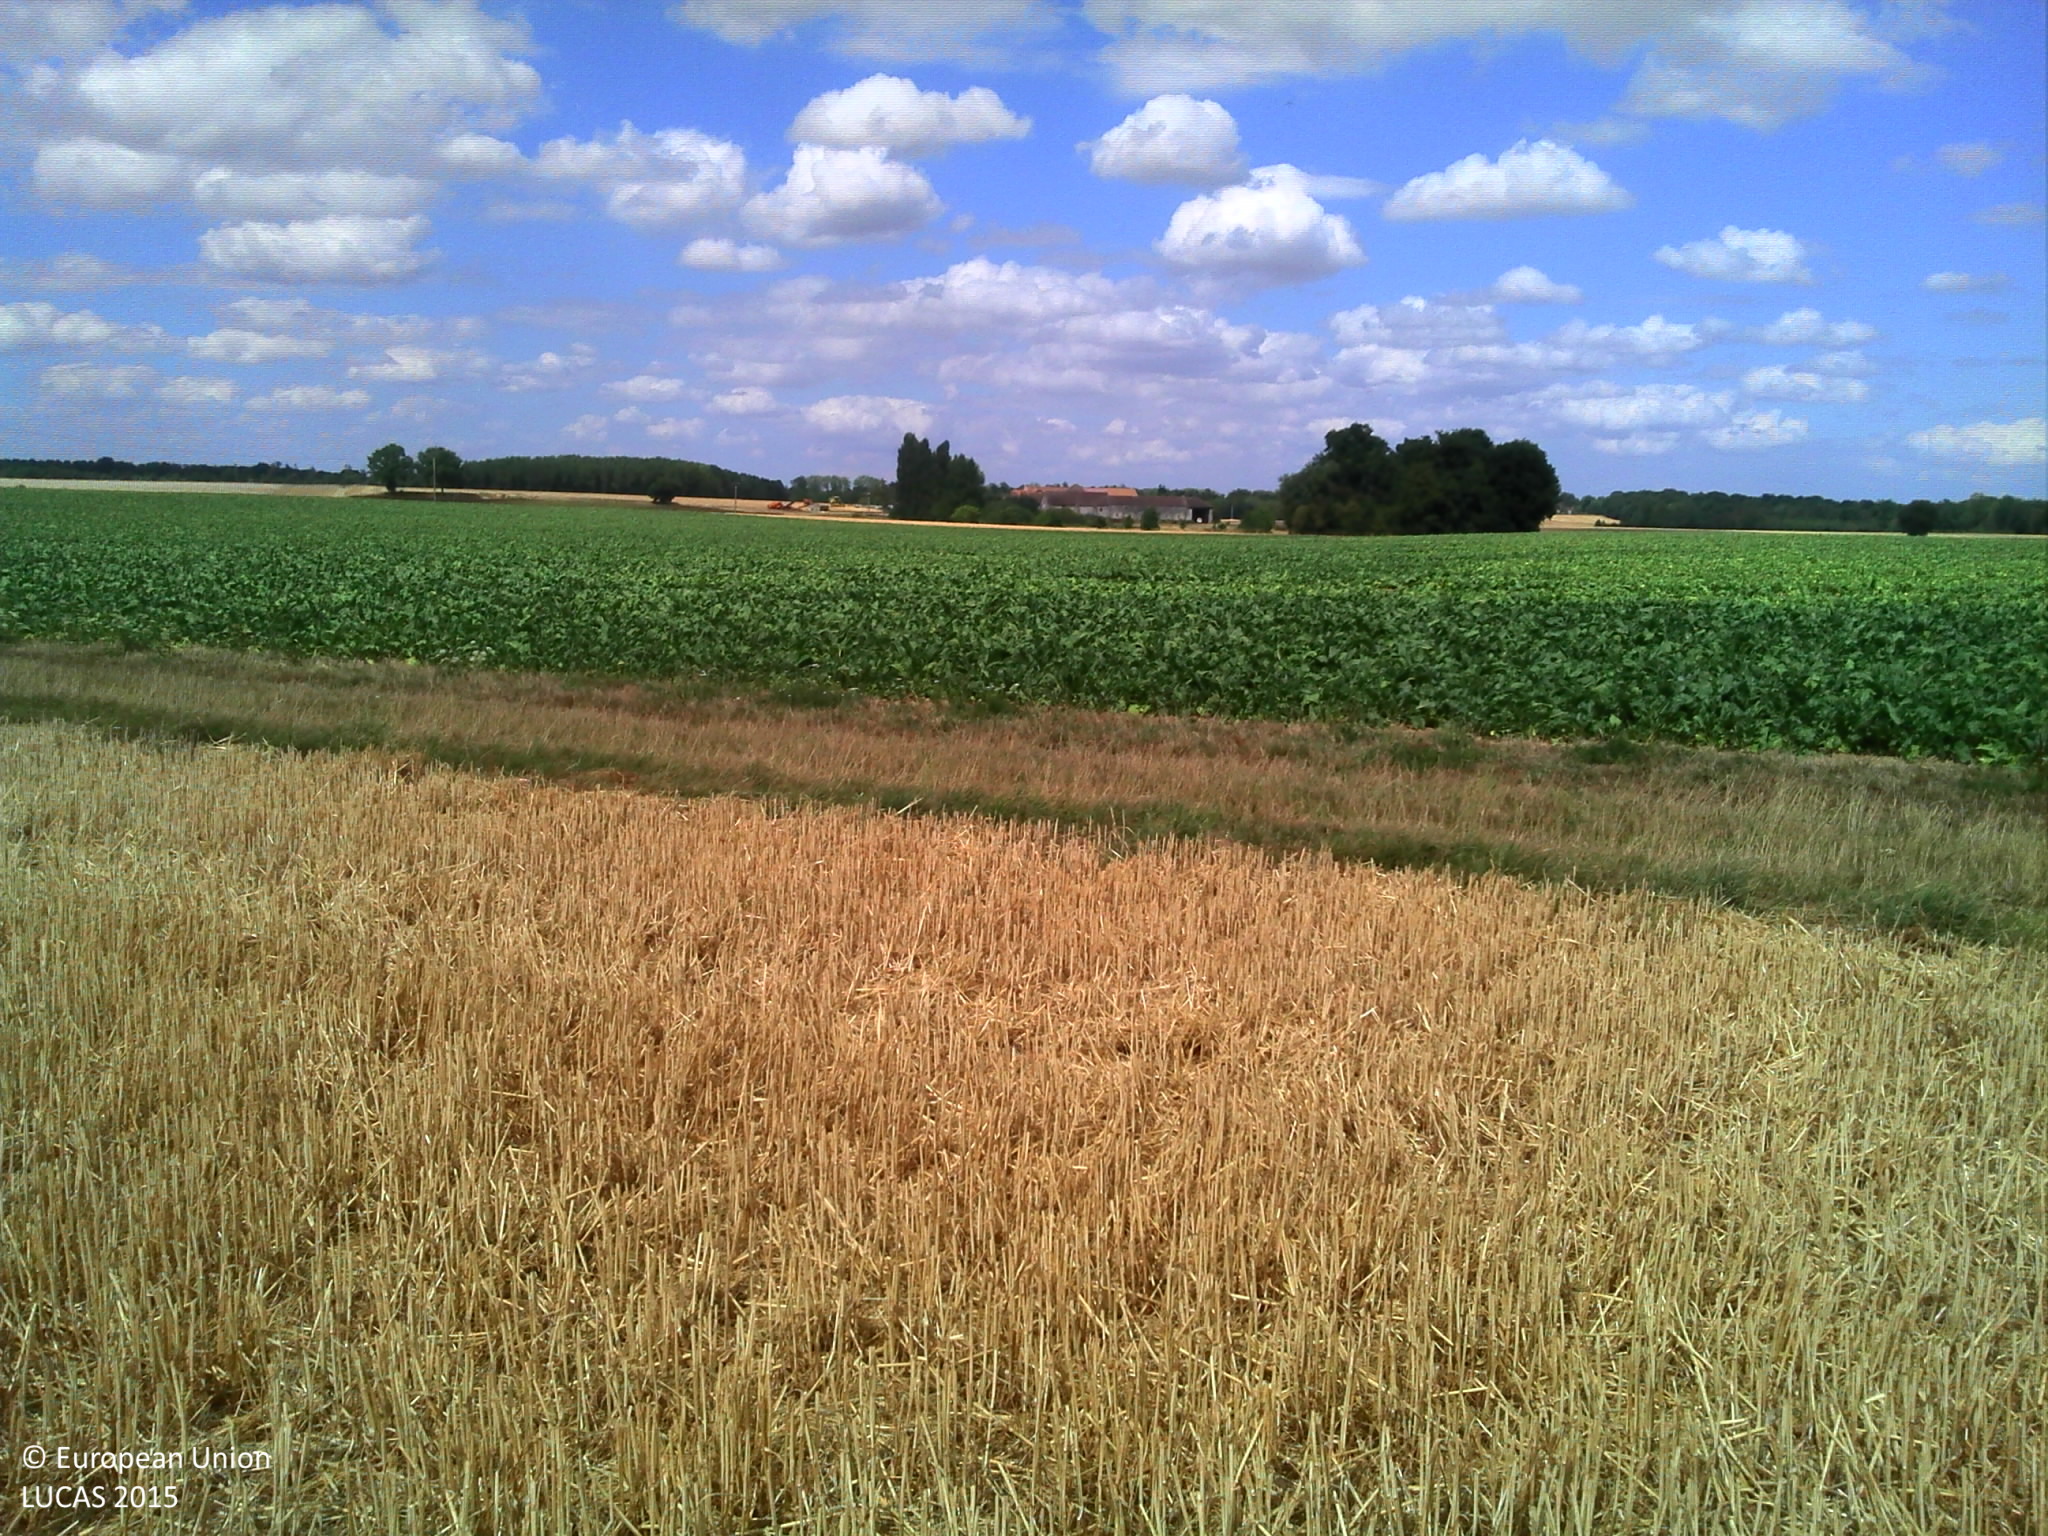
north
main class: Cropland
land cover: Common wheat
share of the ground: 10 - 25 %
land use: Agriculture (excluding fallow land and kitchen gardens)
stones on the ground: 10 - 25 %
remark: Harvested field
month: August
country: FR
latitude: 48.6190
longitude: 3.3597
